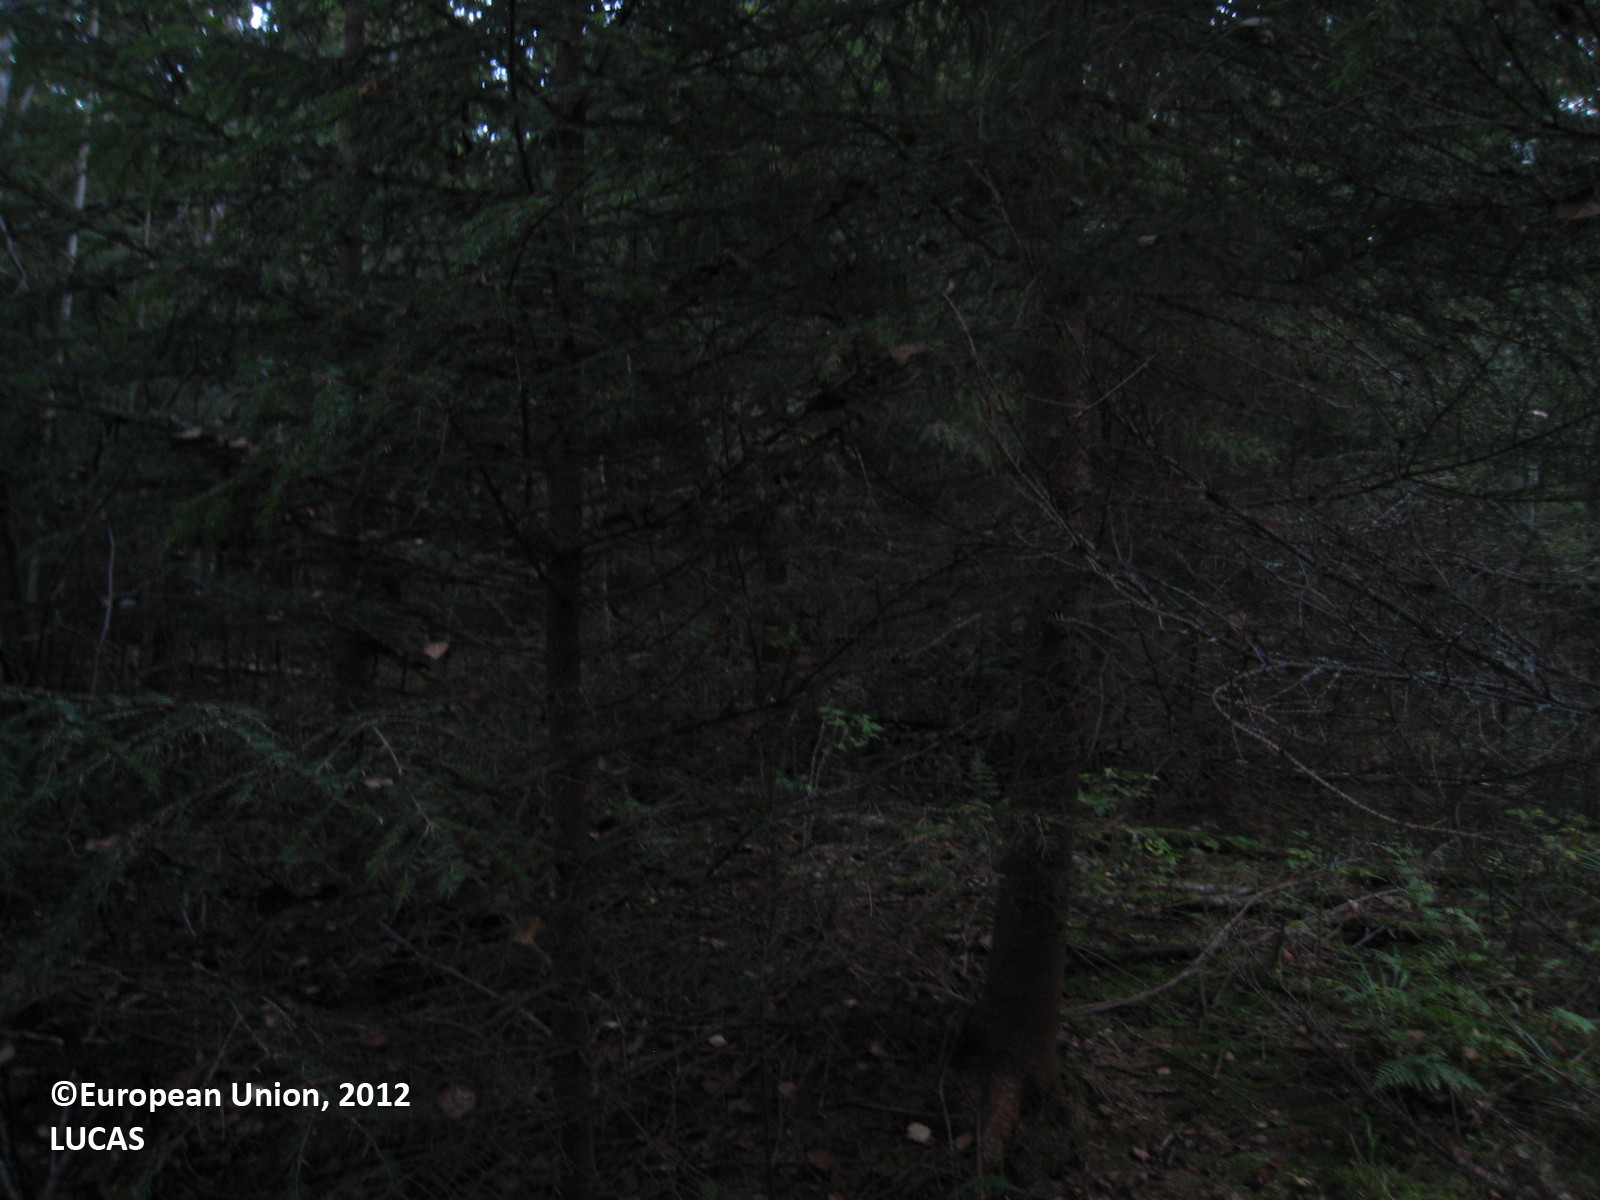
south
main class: Woodland
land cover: Spruce dominated mixed woodland
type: boreal forest
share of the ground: > 75 %
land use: Forestry
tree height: > 5 m
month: September
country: FI
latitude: 62.7972
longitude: 26.5475
